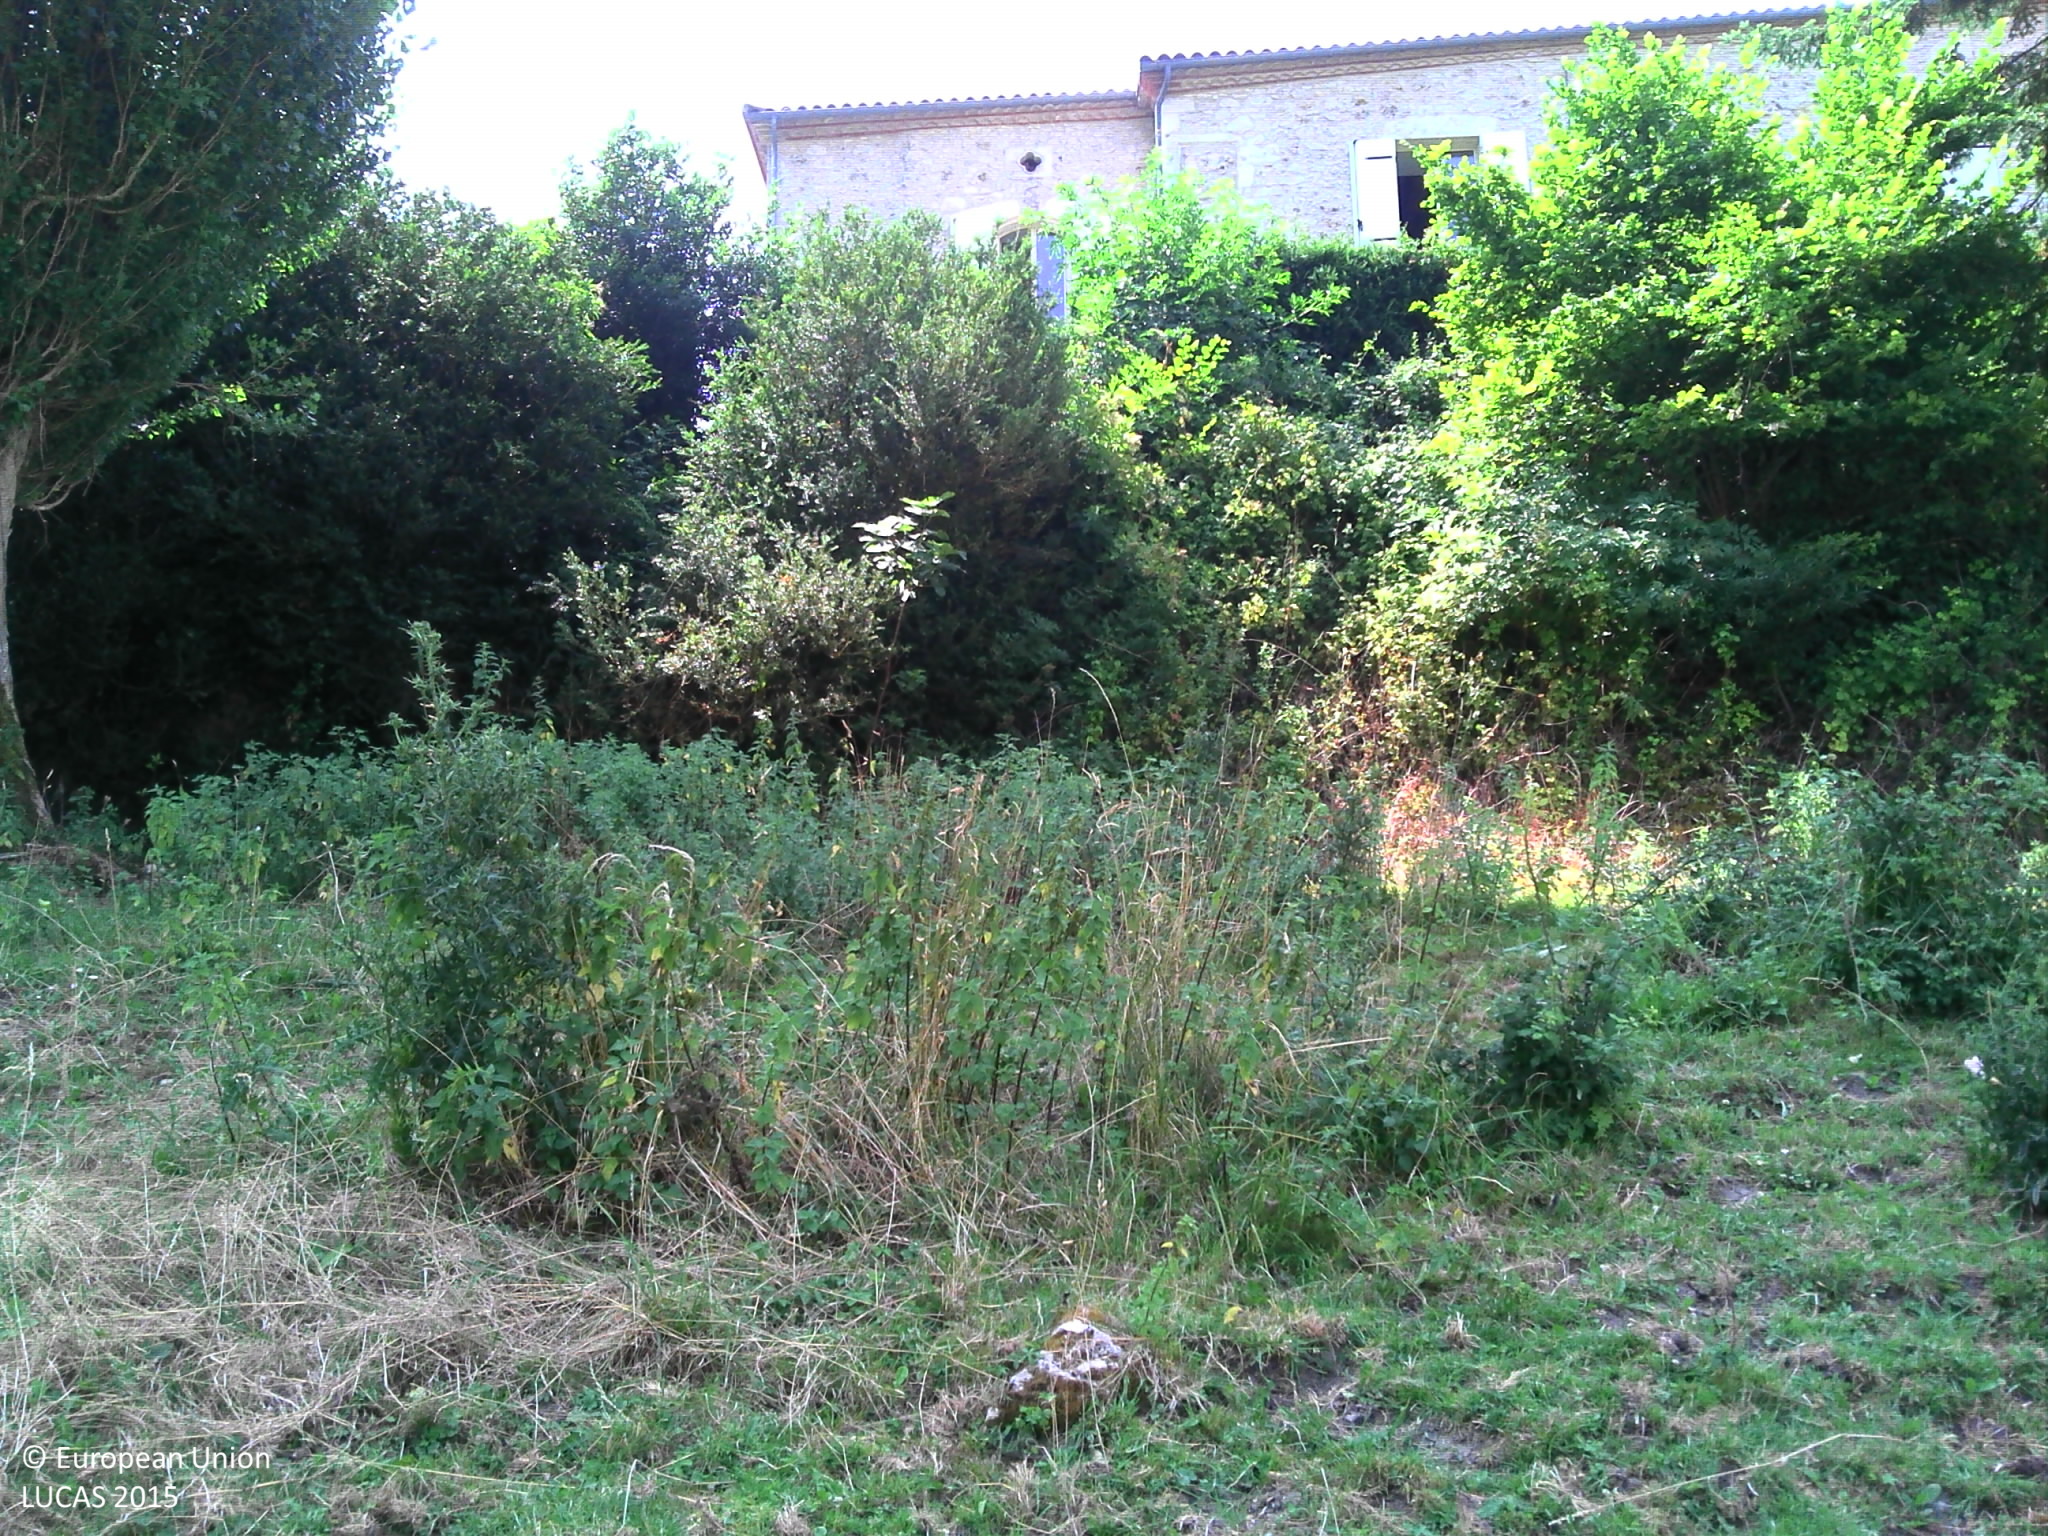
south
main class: Grassland
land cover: Grassland without tree/shrub cover
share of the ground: > 75 %
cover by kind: herbaceous plants 100 %
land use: Agriculture (excluding fallow land and kitchen gardens)
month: July
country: FR
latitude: 44.3090
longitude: 0.8567
